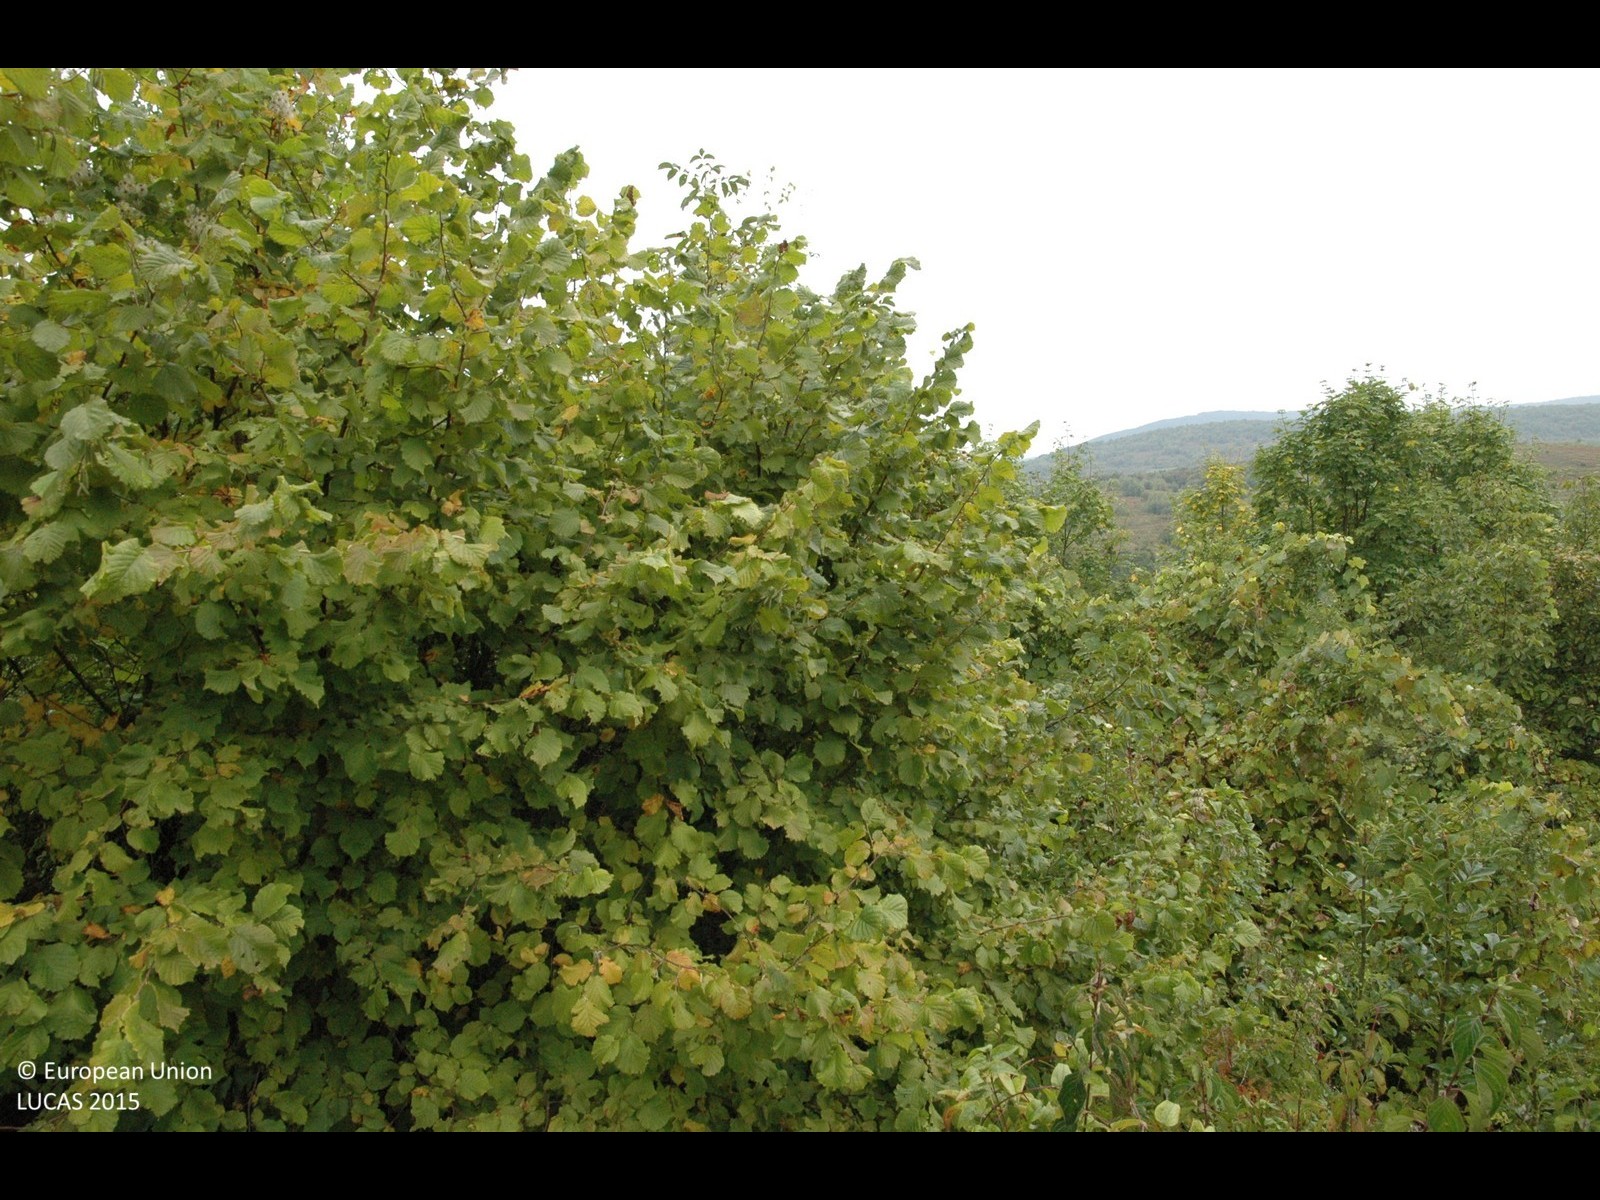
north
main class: Shrubland
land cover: Shrubland with sparse tree cover
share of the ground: > 75 %
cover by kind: shrubs 95 %, broadleaved forest trees 5 %
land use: Semi-natural and natural areas not in use
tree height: > 5 m
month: September
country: HR
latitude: 45.0103
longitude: 15.6412
